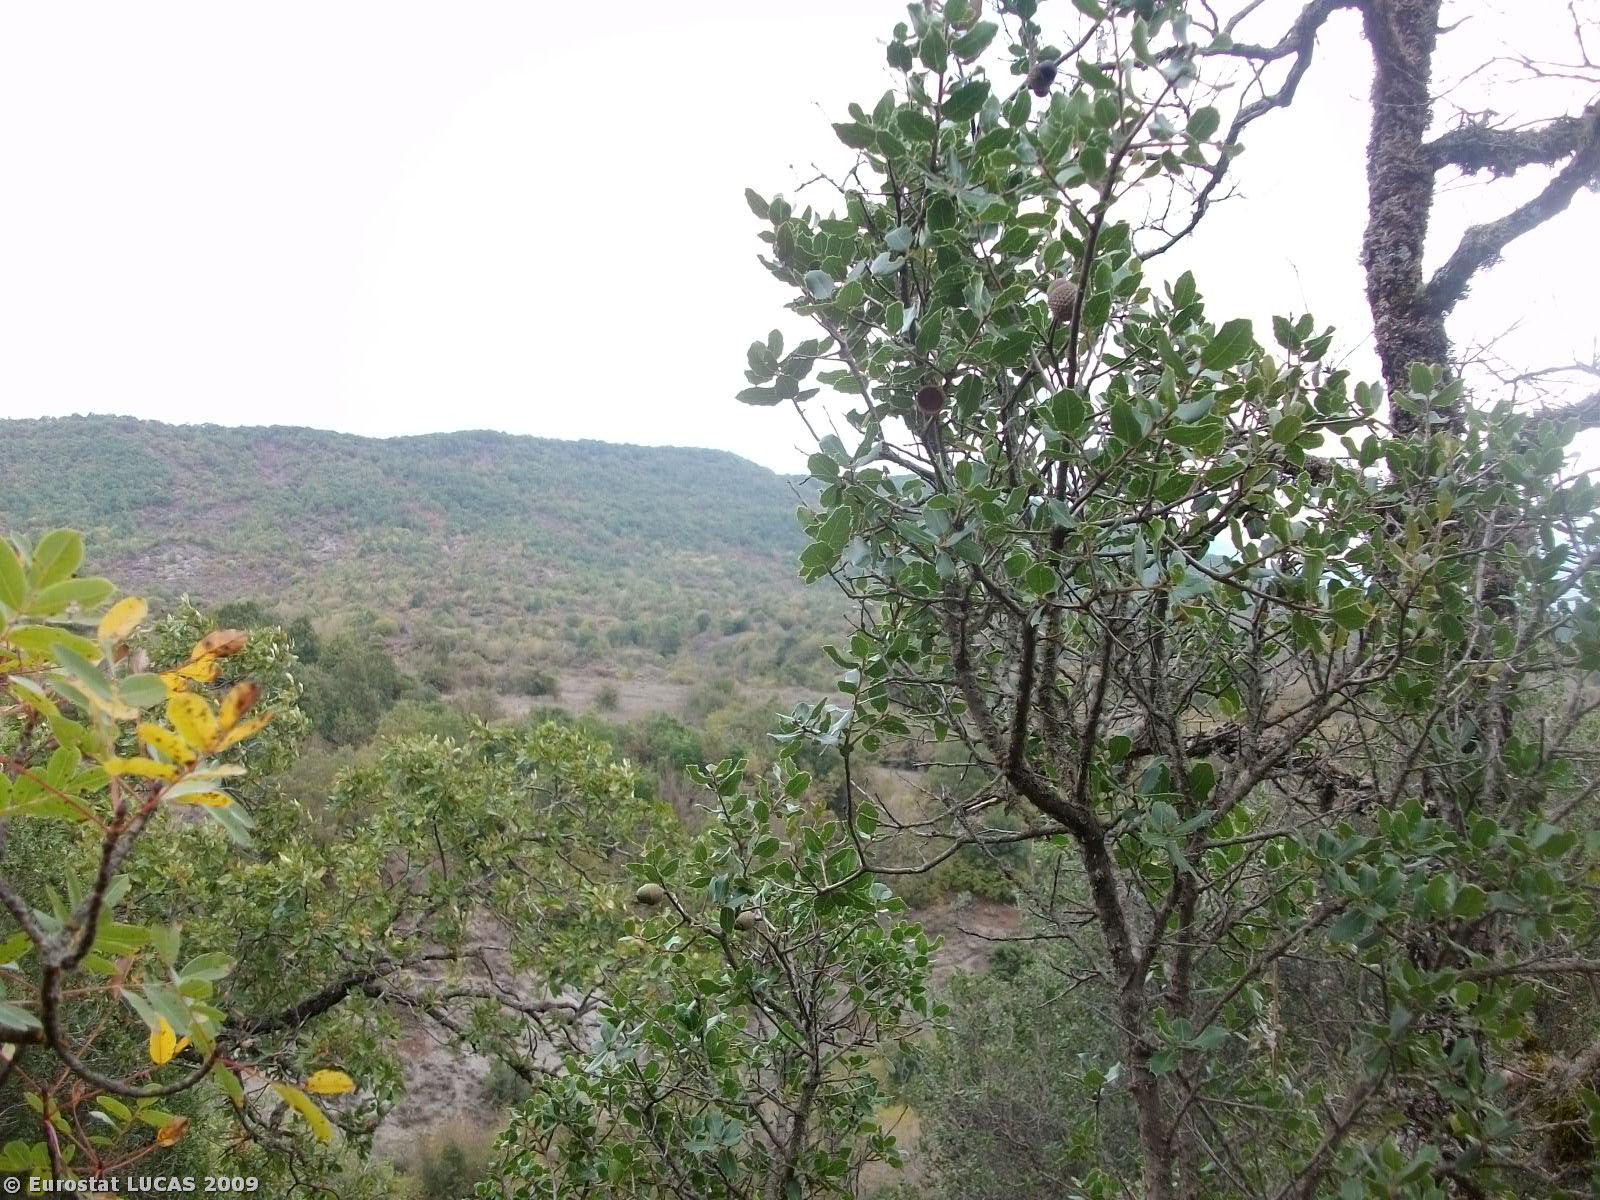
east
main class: Shrubland
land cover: Shrubland with sparse tree cover
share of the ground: > 75 %
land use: Unused
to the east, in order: Shrubland with sparse tree cover; Shrubland without tree cover; Bare land; Shrubland without tree cover; Broadleaved woodland; Rivers and streams; Bare land; Broadleaved woodland; Grassland with sparse tree/shrub cover; Shrubland with sparse tree cover
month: October
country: GR
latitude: 39.8955
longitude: 20.3990
